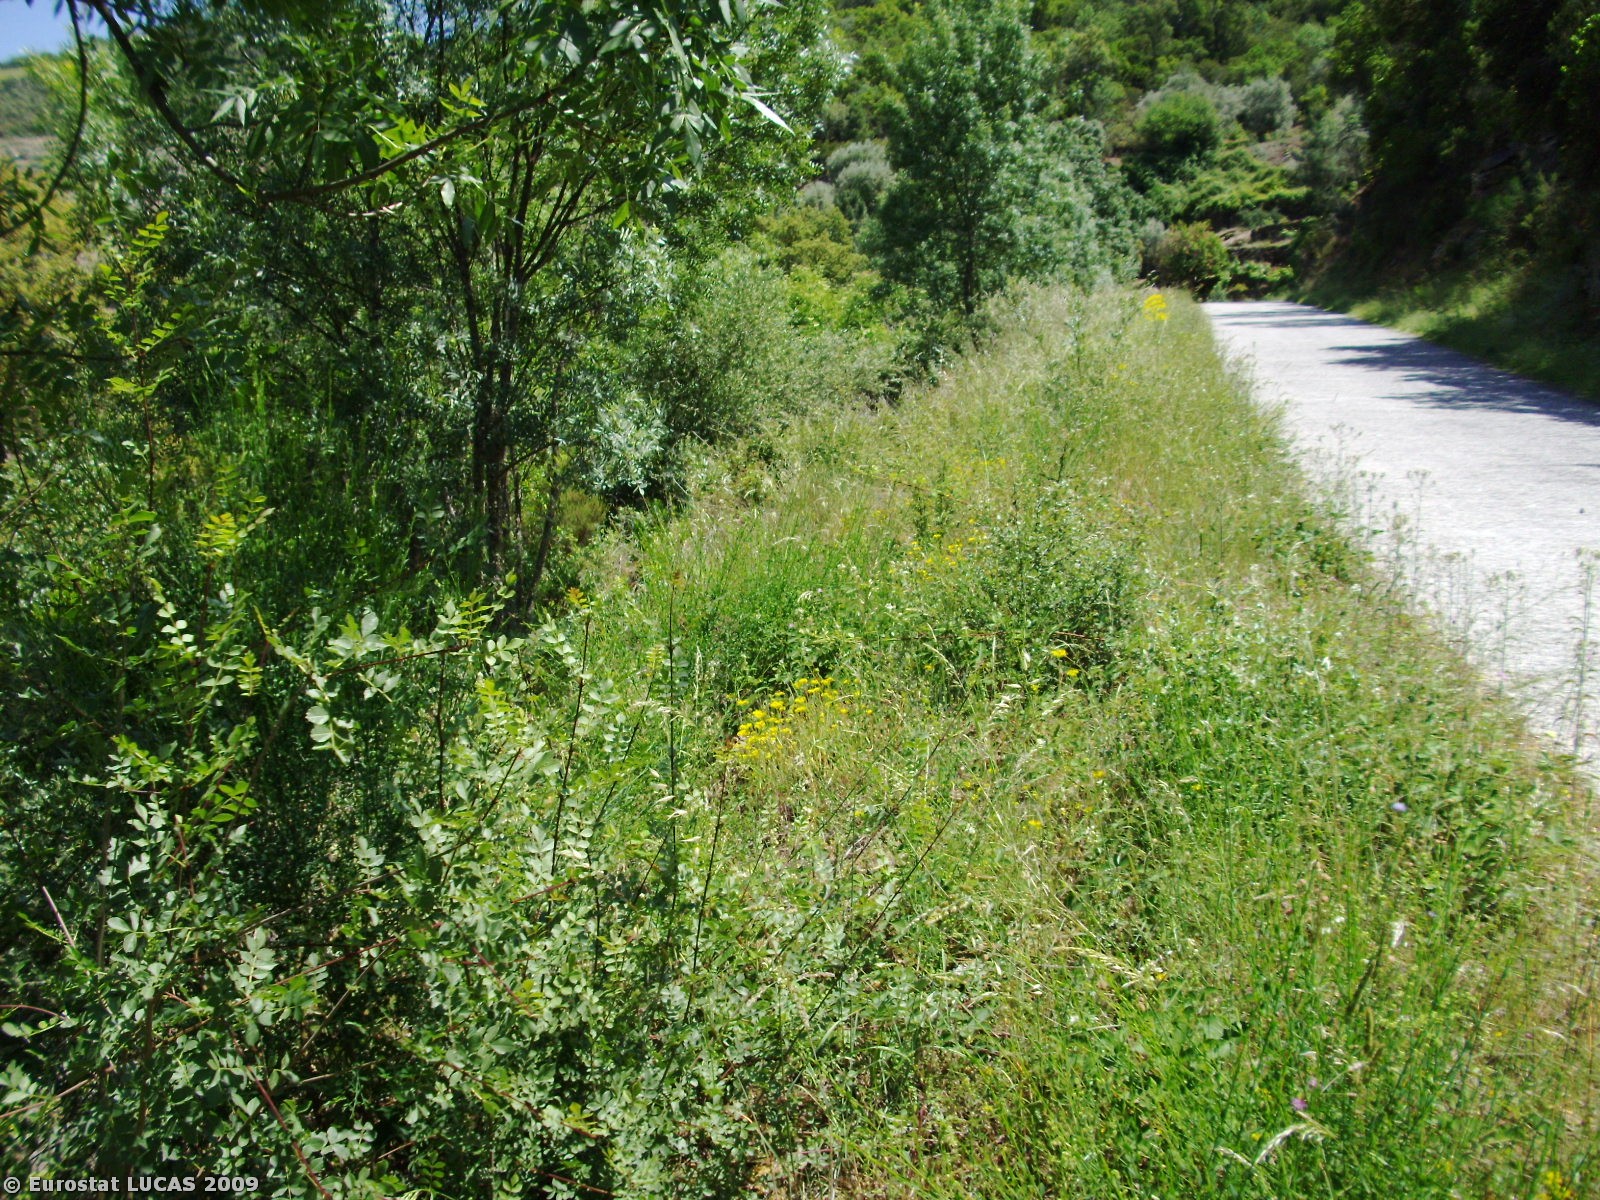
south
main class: Cropland
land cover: Potatoes
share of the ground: 50 - 75 %
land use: Agriculture (excluding fallow land and kitchen gardens)
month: May
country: PT
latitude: 41.1311
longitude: -7.6235
